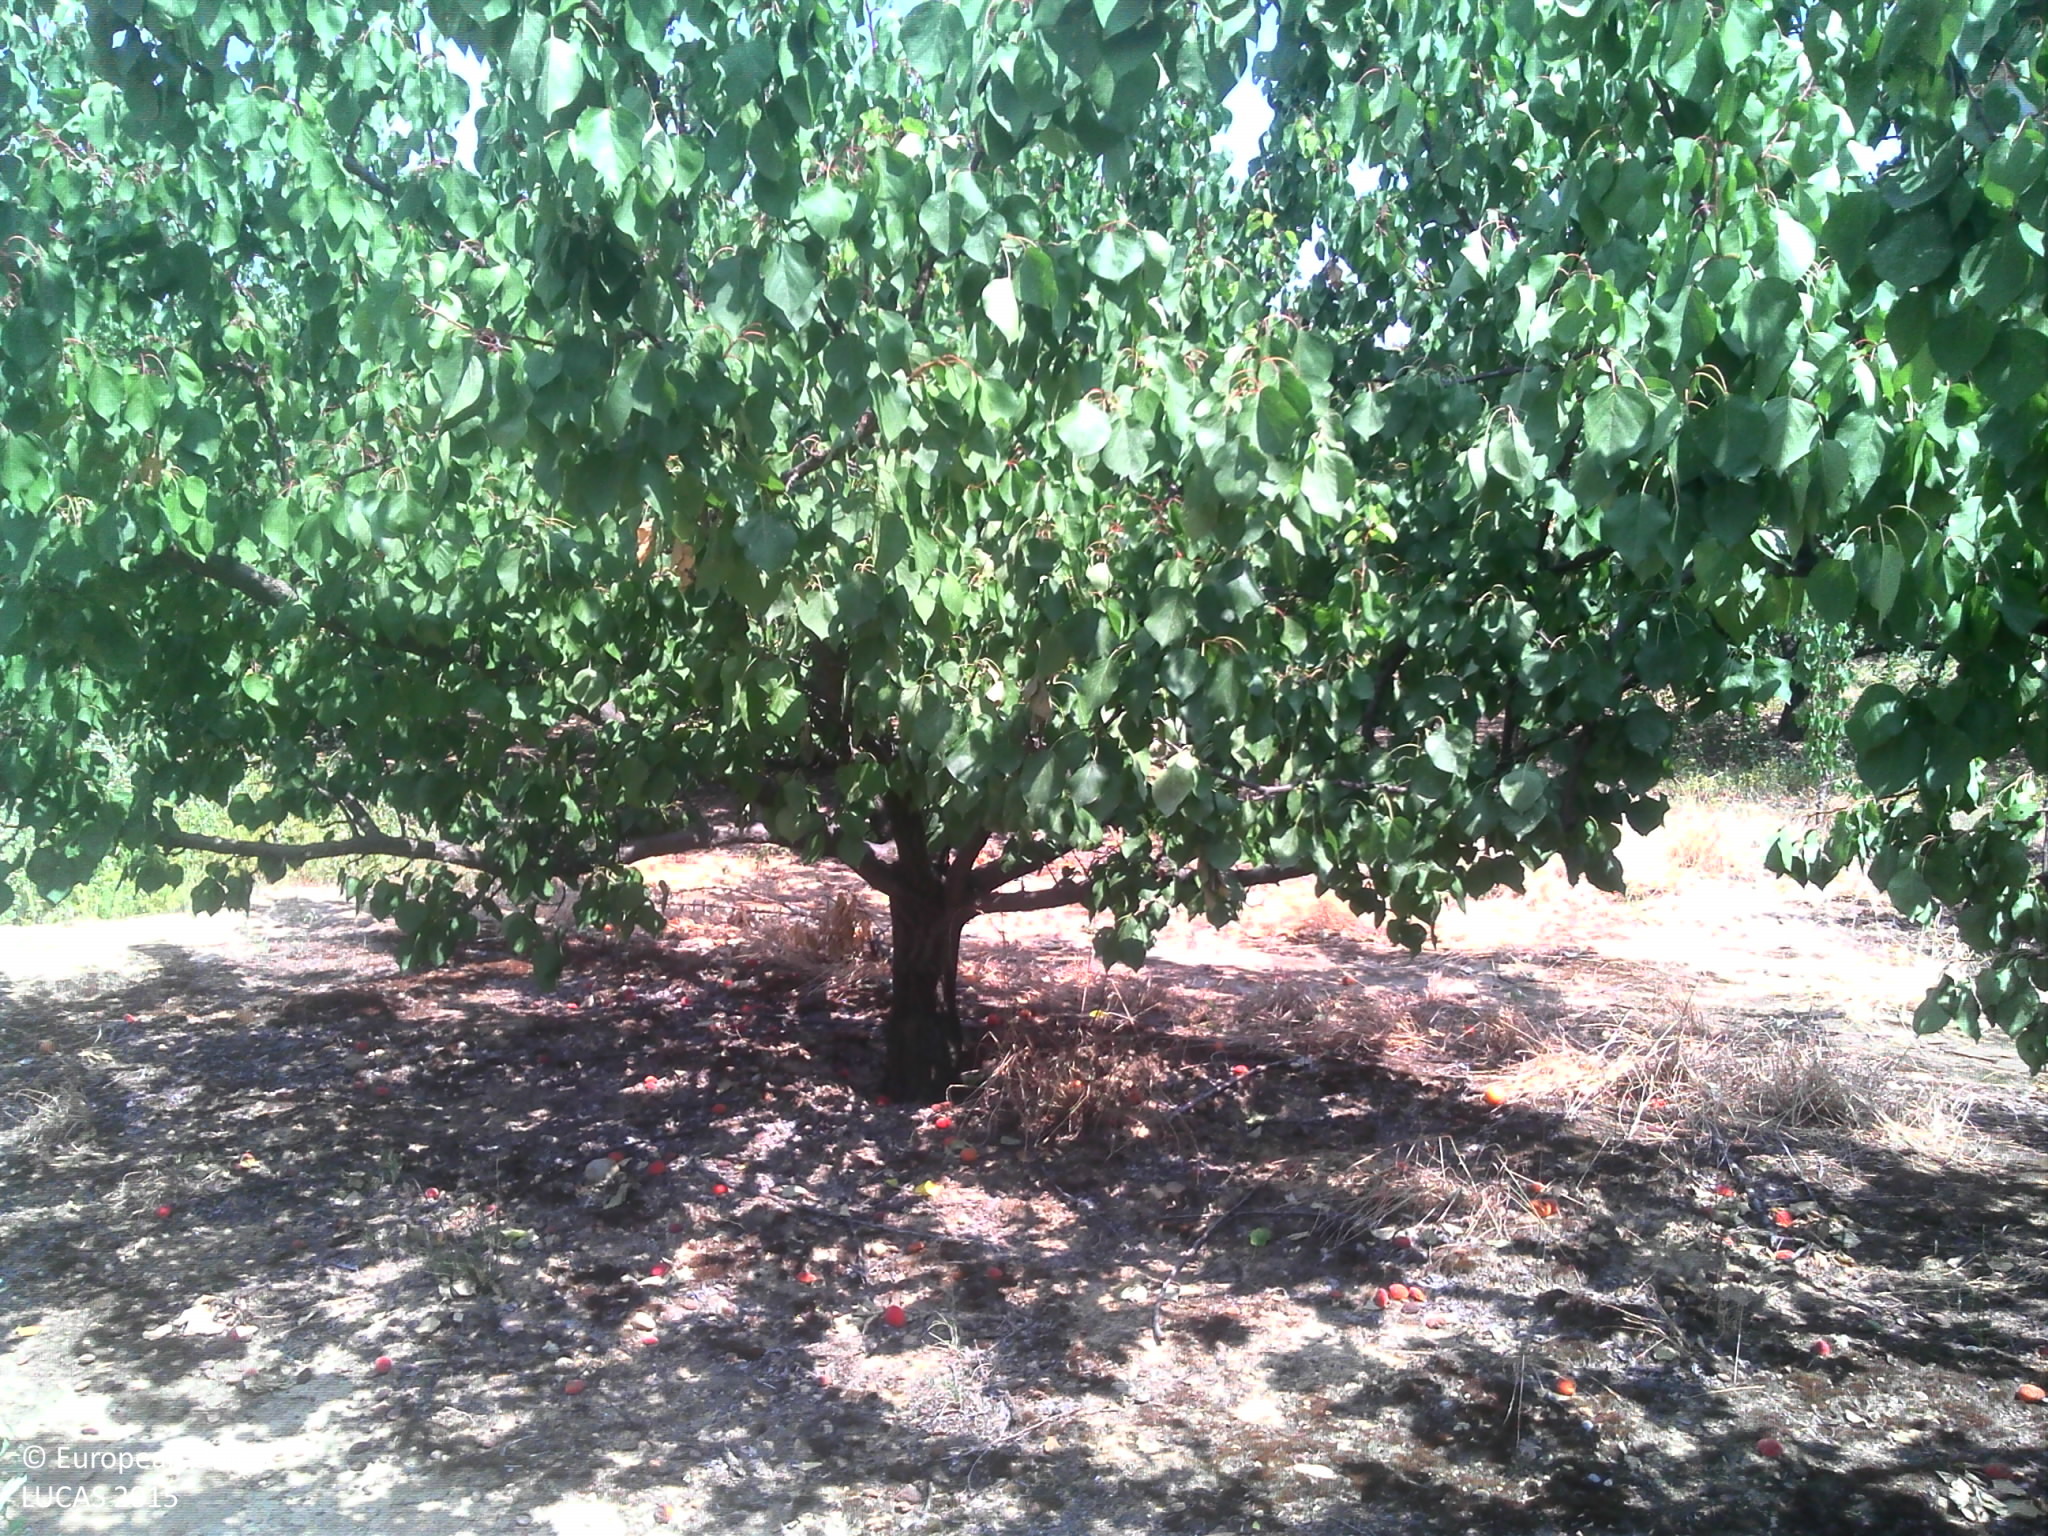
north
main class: Cropland
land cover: Other fruit trees and berries
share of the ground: > 75 %
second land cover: Other bare soil
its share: > 75 %
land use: Agriculture (excluding fallow land and kitchen gardens)
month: July
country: FR
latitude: 44.3199
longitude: 4.6284
